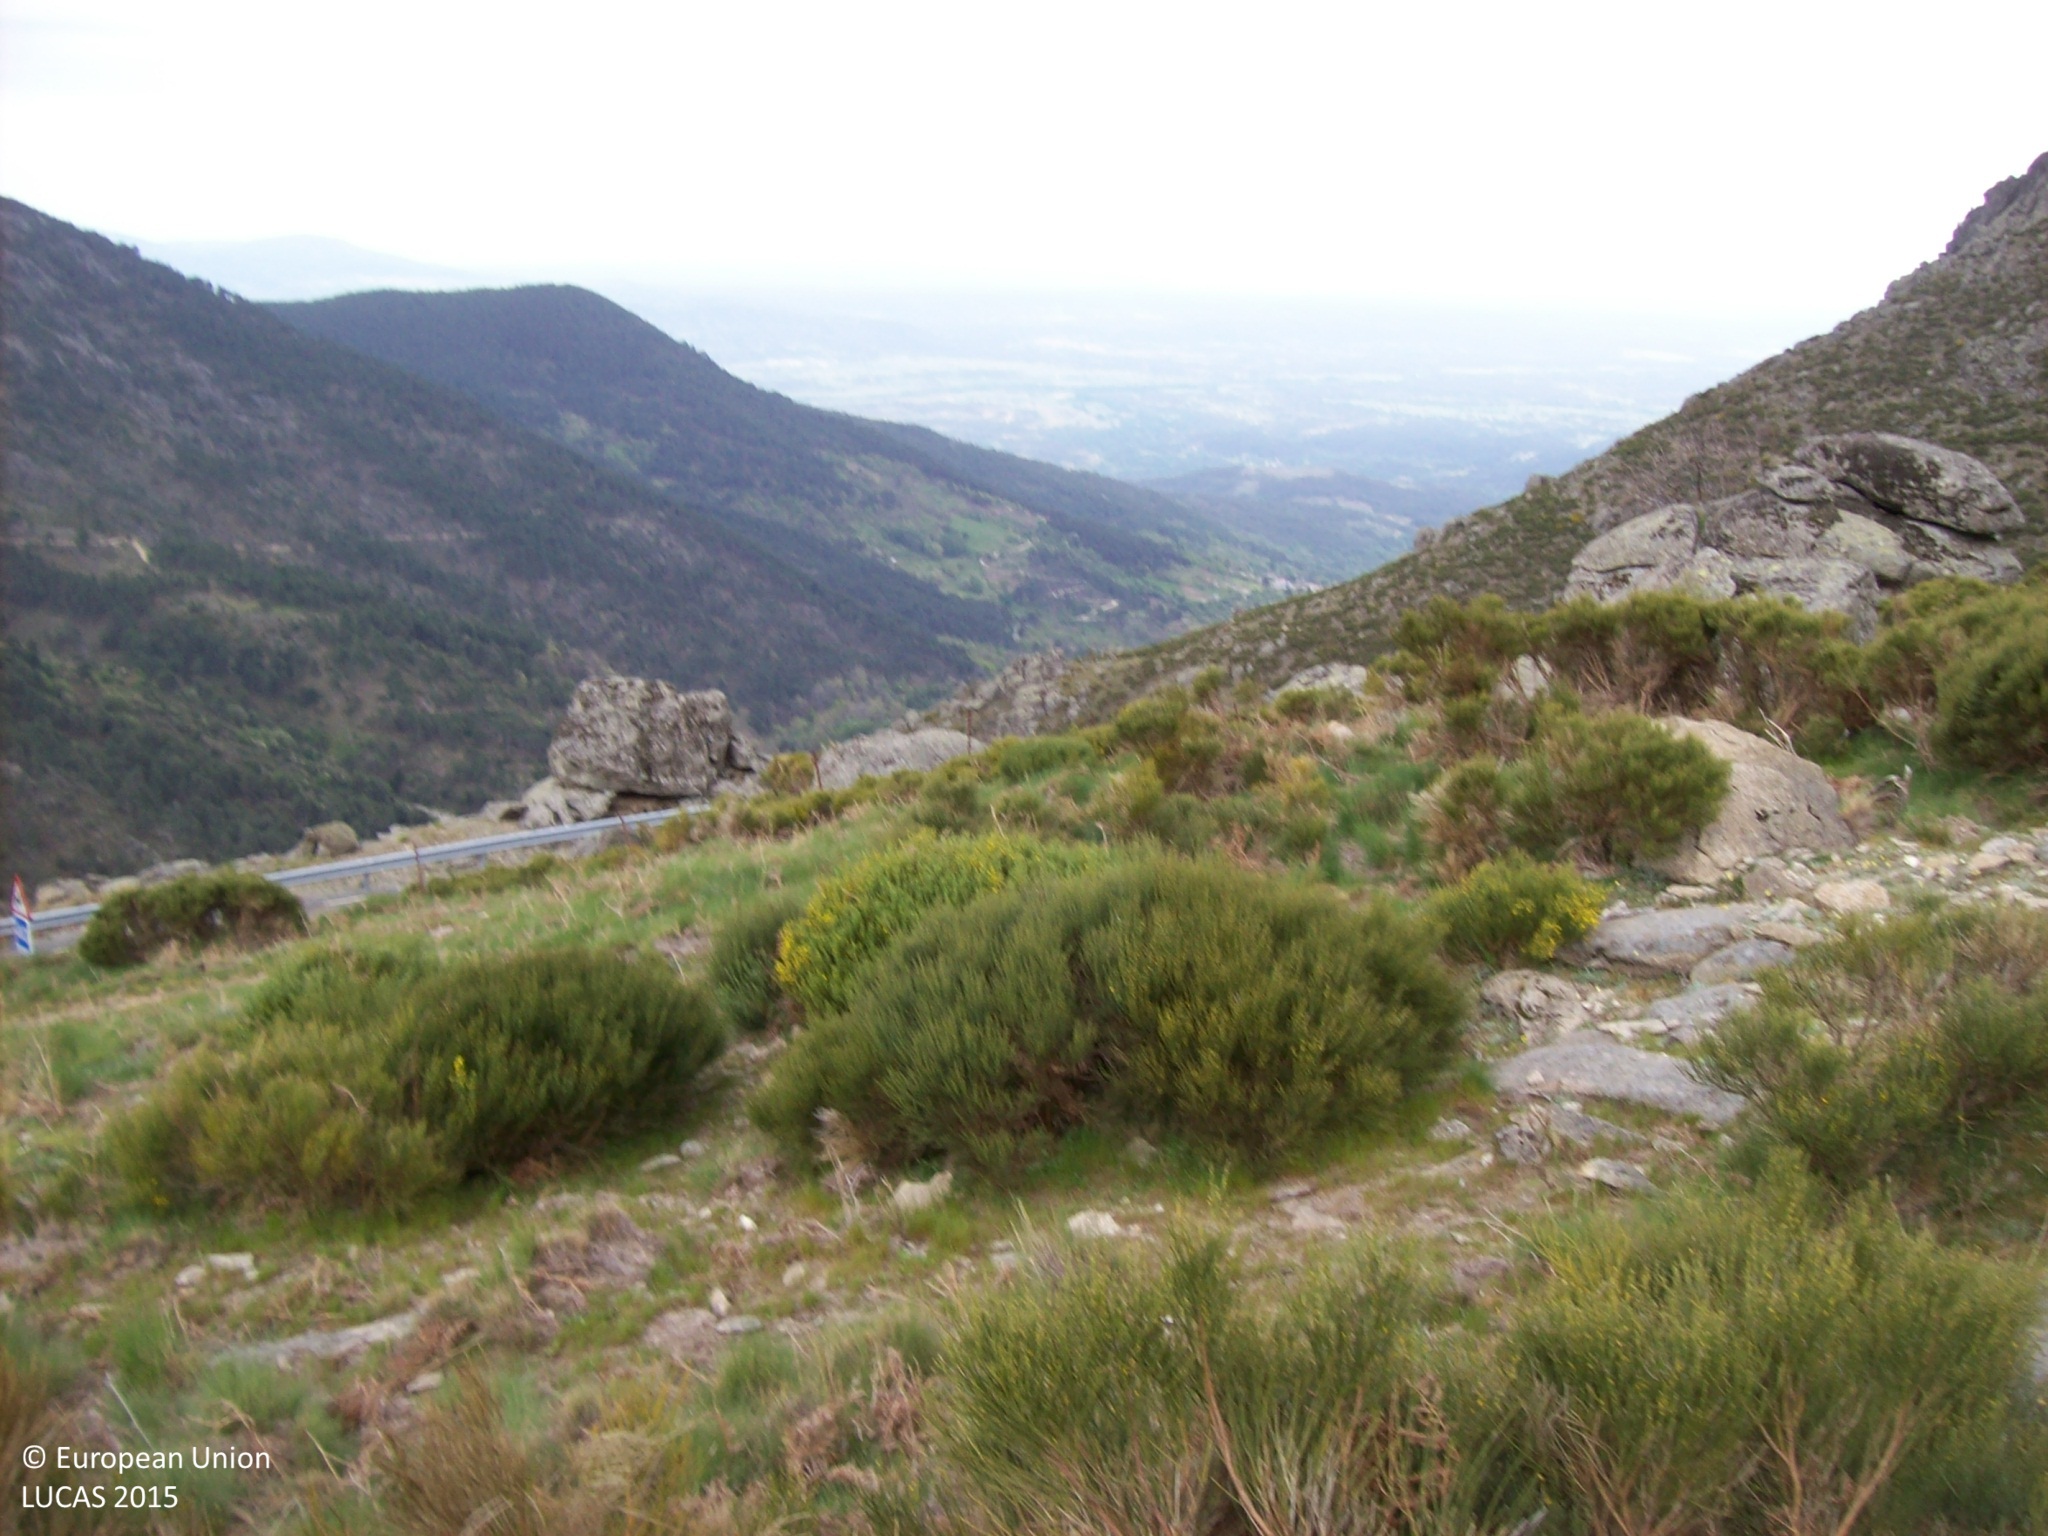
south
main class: Shrubland
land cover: Shrubland without tree cover
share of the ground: 25 - 50 %
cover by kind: shrubs 30 %, herbaceous plants 30 %, consolidated bare surface 30 %, unconsolidated bare surface 10 %
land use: Agriculture (excluding fallow land and kitchen gardens)
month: April
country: ES
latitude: 40.3274
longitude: -4.8239
